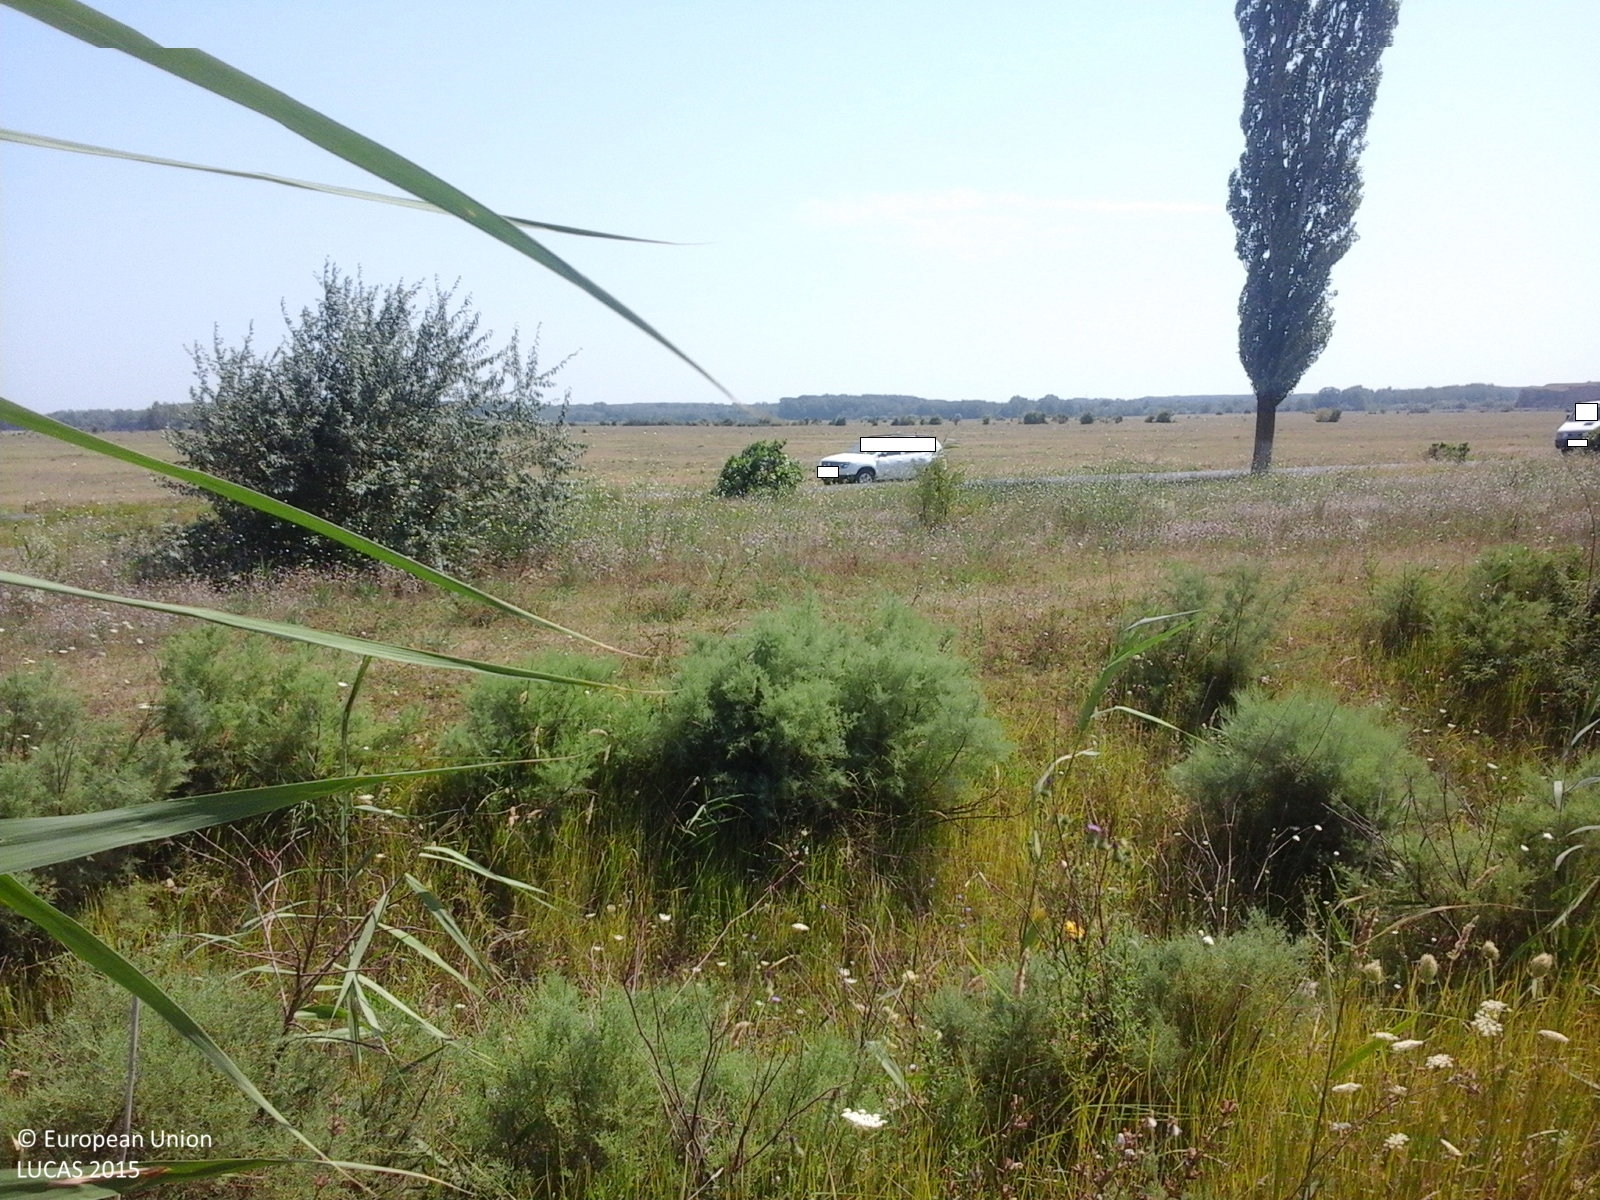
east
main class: Cropland
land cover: Maize
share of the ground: > 75 %
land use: Agriculture (excluding fallow land and kitchen gardens)
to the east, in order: Maize; Shruby margins; Ditches and canals; Spontaneously vegetated surfaces; Lines of trees; Grass margins; Paved roads, cycling and walking lanes; Lines of trees; Grassland without tree/shrub cover; Tracks; Grassland without tree/shrub cover
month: August
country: RO
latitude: 45.2406
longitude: 27.4100
